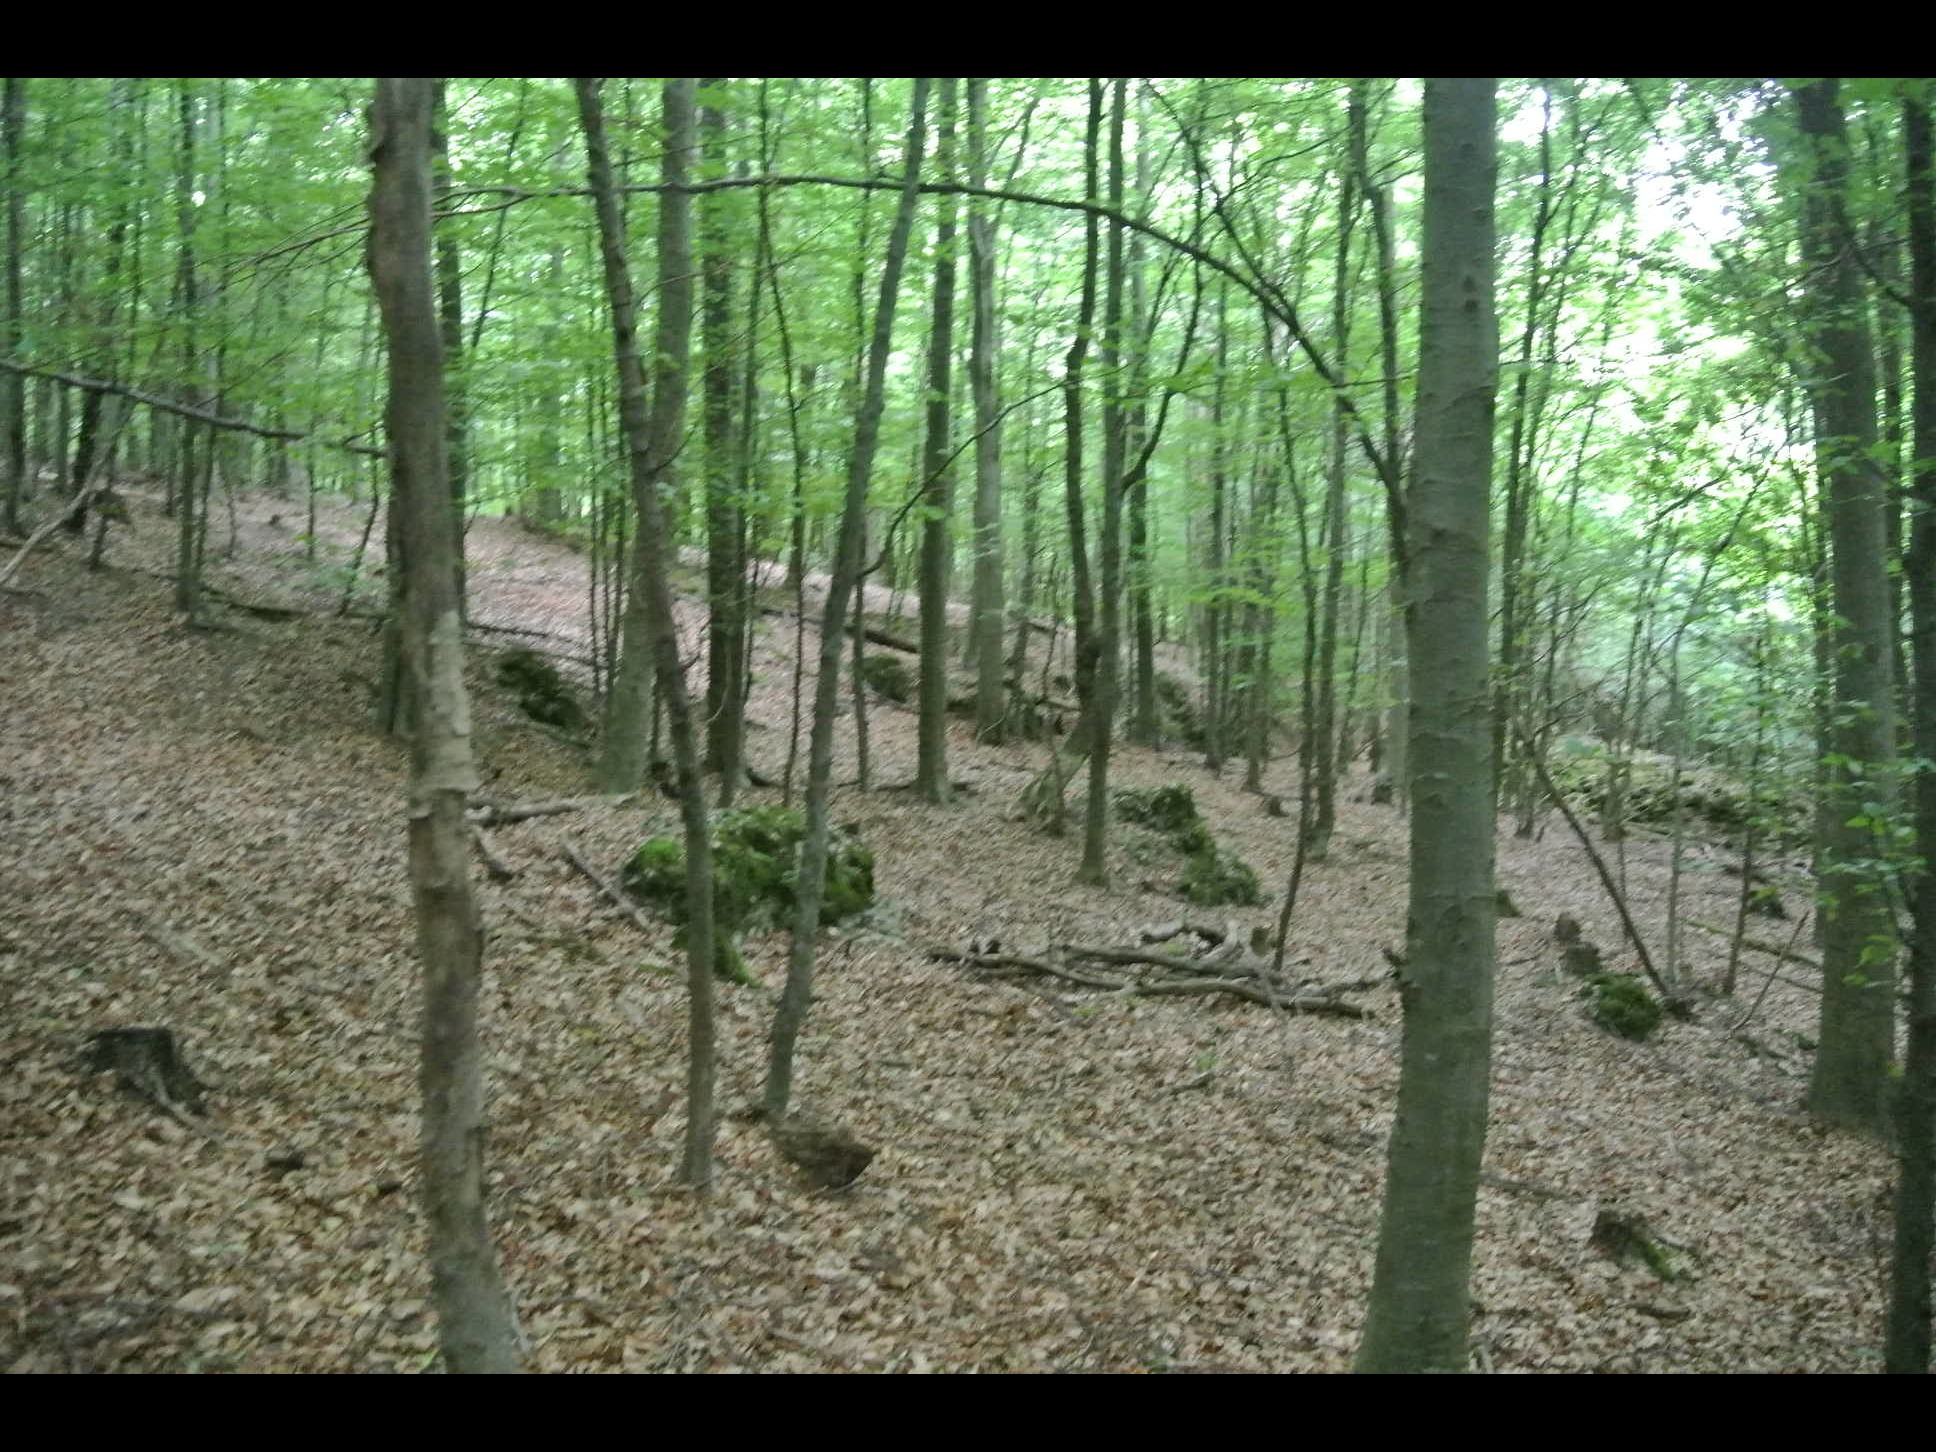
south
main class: Woodland
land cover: Broadleaved woodland
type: beech forest
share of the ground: > 75 %
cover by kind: broadleaved forest trees 100 %
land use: Forestry
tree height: > 5 m
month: July
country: AT
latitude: 47.6206
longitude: 16.4305
